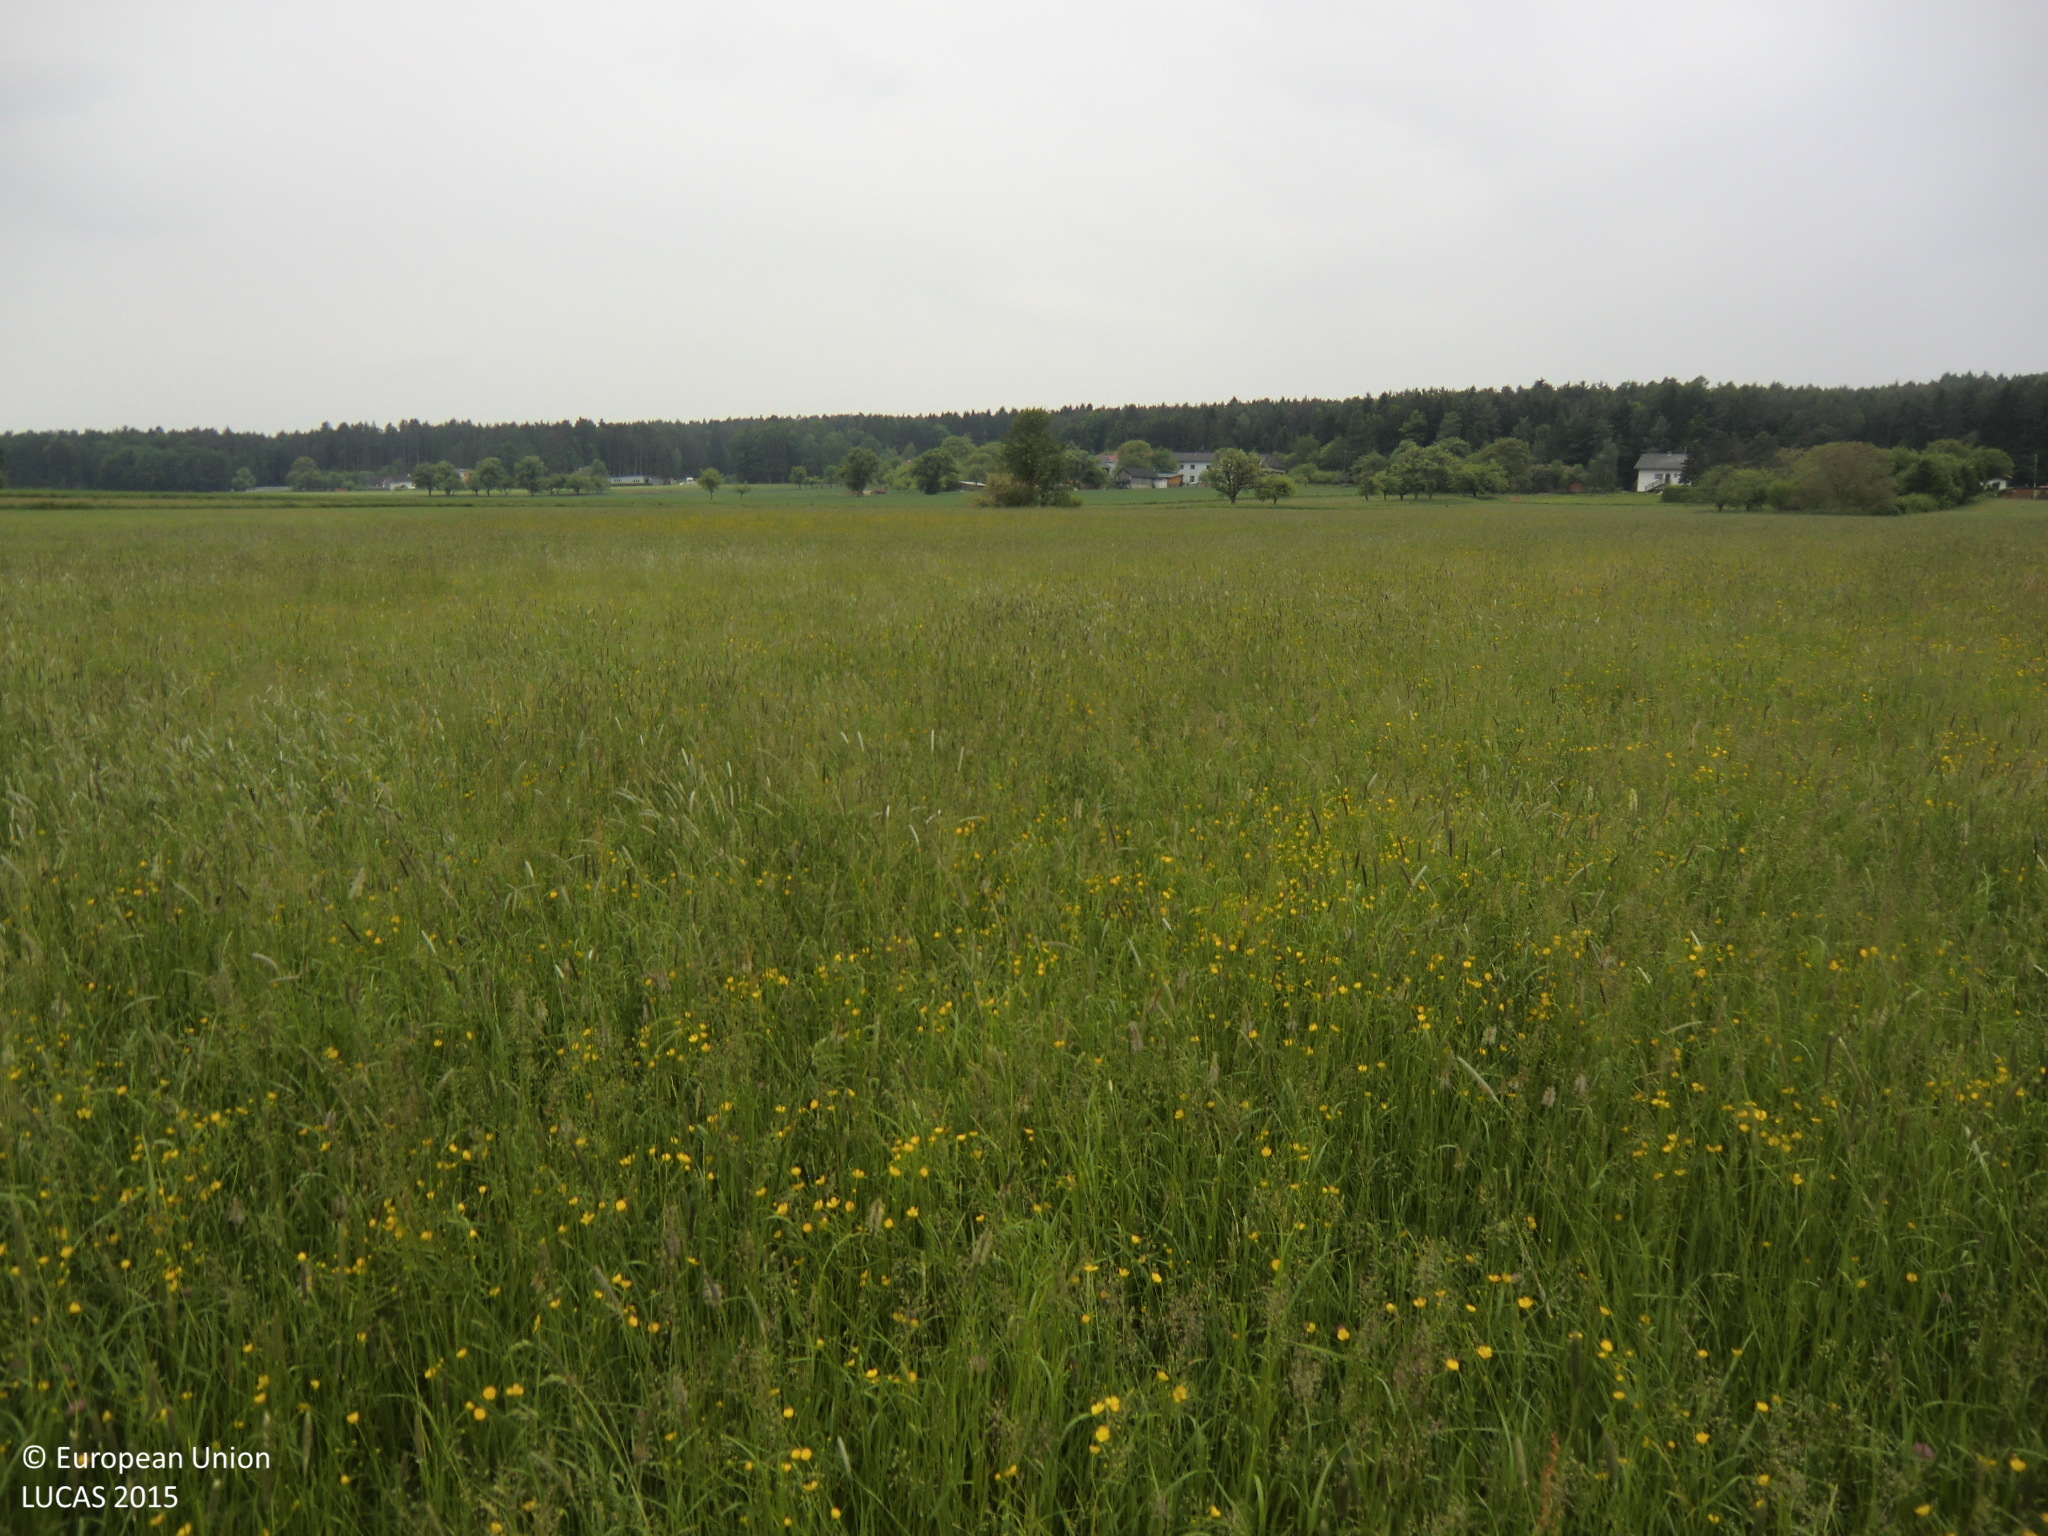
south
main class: Grassland
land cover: Grassland without tree/shrub cover
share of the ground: > 75 %
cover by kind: herbaceous plants 100 %
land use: Agriculture (excluding fallow land and kitchen gardens)
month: May
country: AT
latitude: 47.3549
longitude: 16.0256
